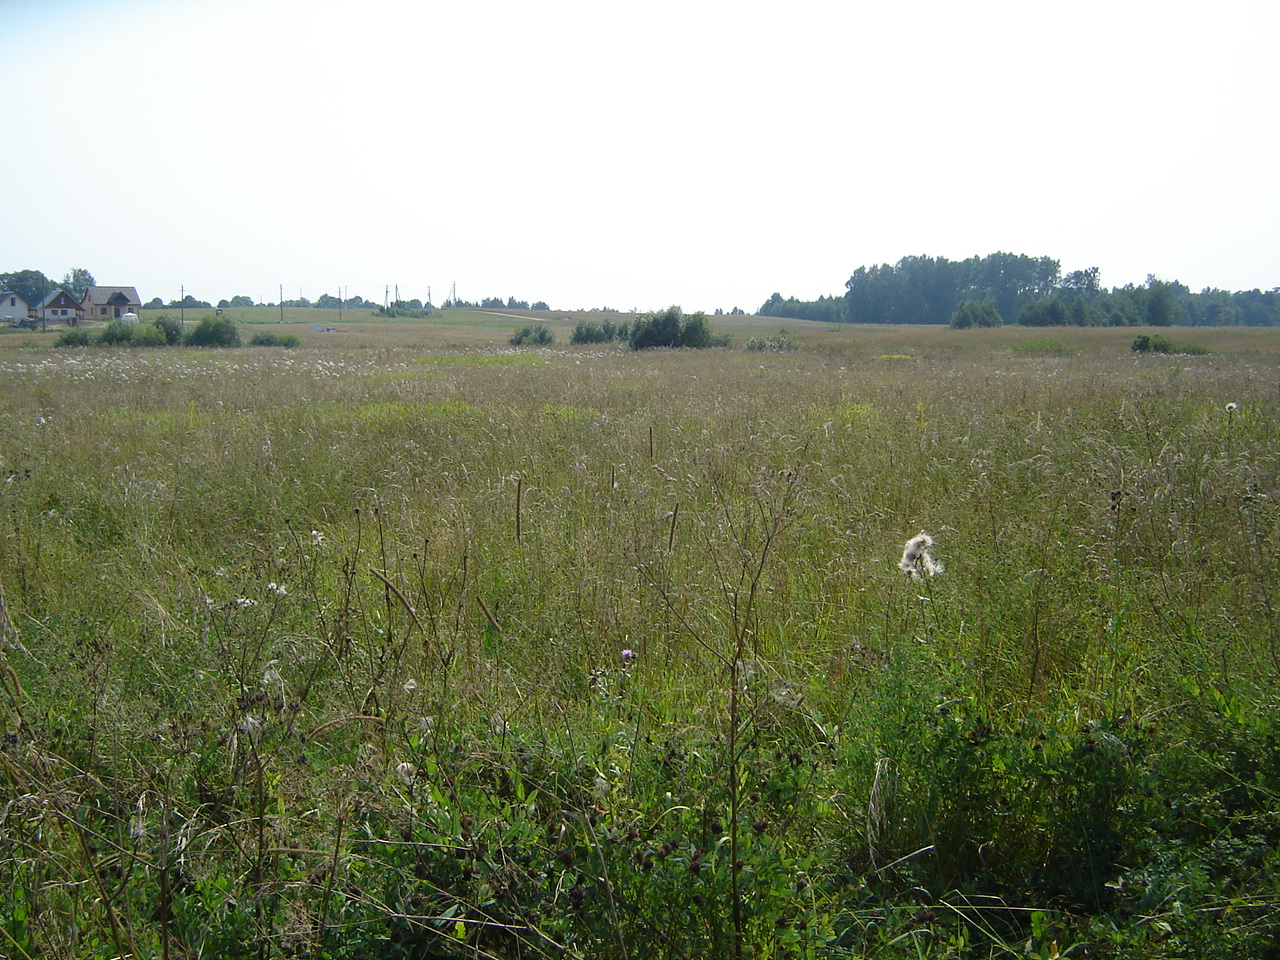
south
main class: Grassland
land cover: Grassland without tree/shrub cover
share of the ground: > 75 %
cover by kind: herbaceous plants 100 %
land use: Agriculture (excluding fallow land and kitchen gardens)
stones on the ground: < 10 %
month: August
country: LT
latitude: 54.8600
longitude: 24.9914
